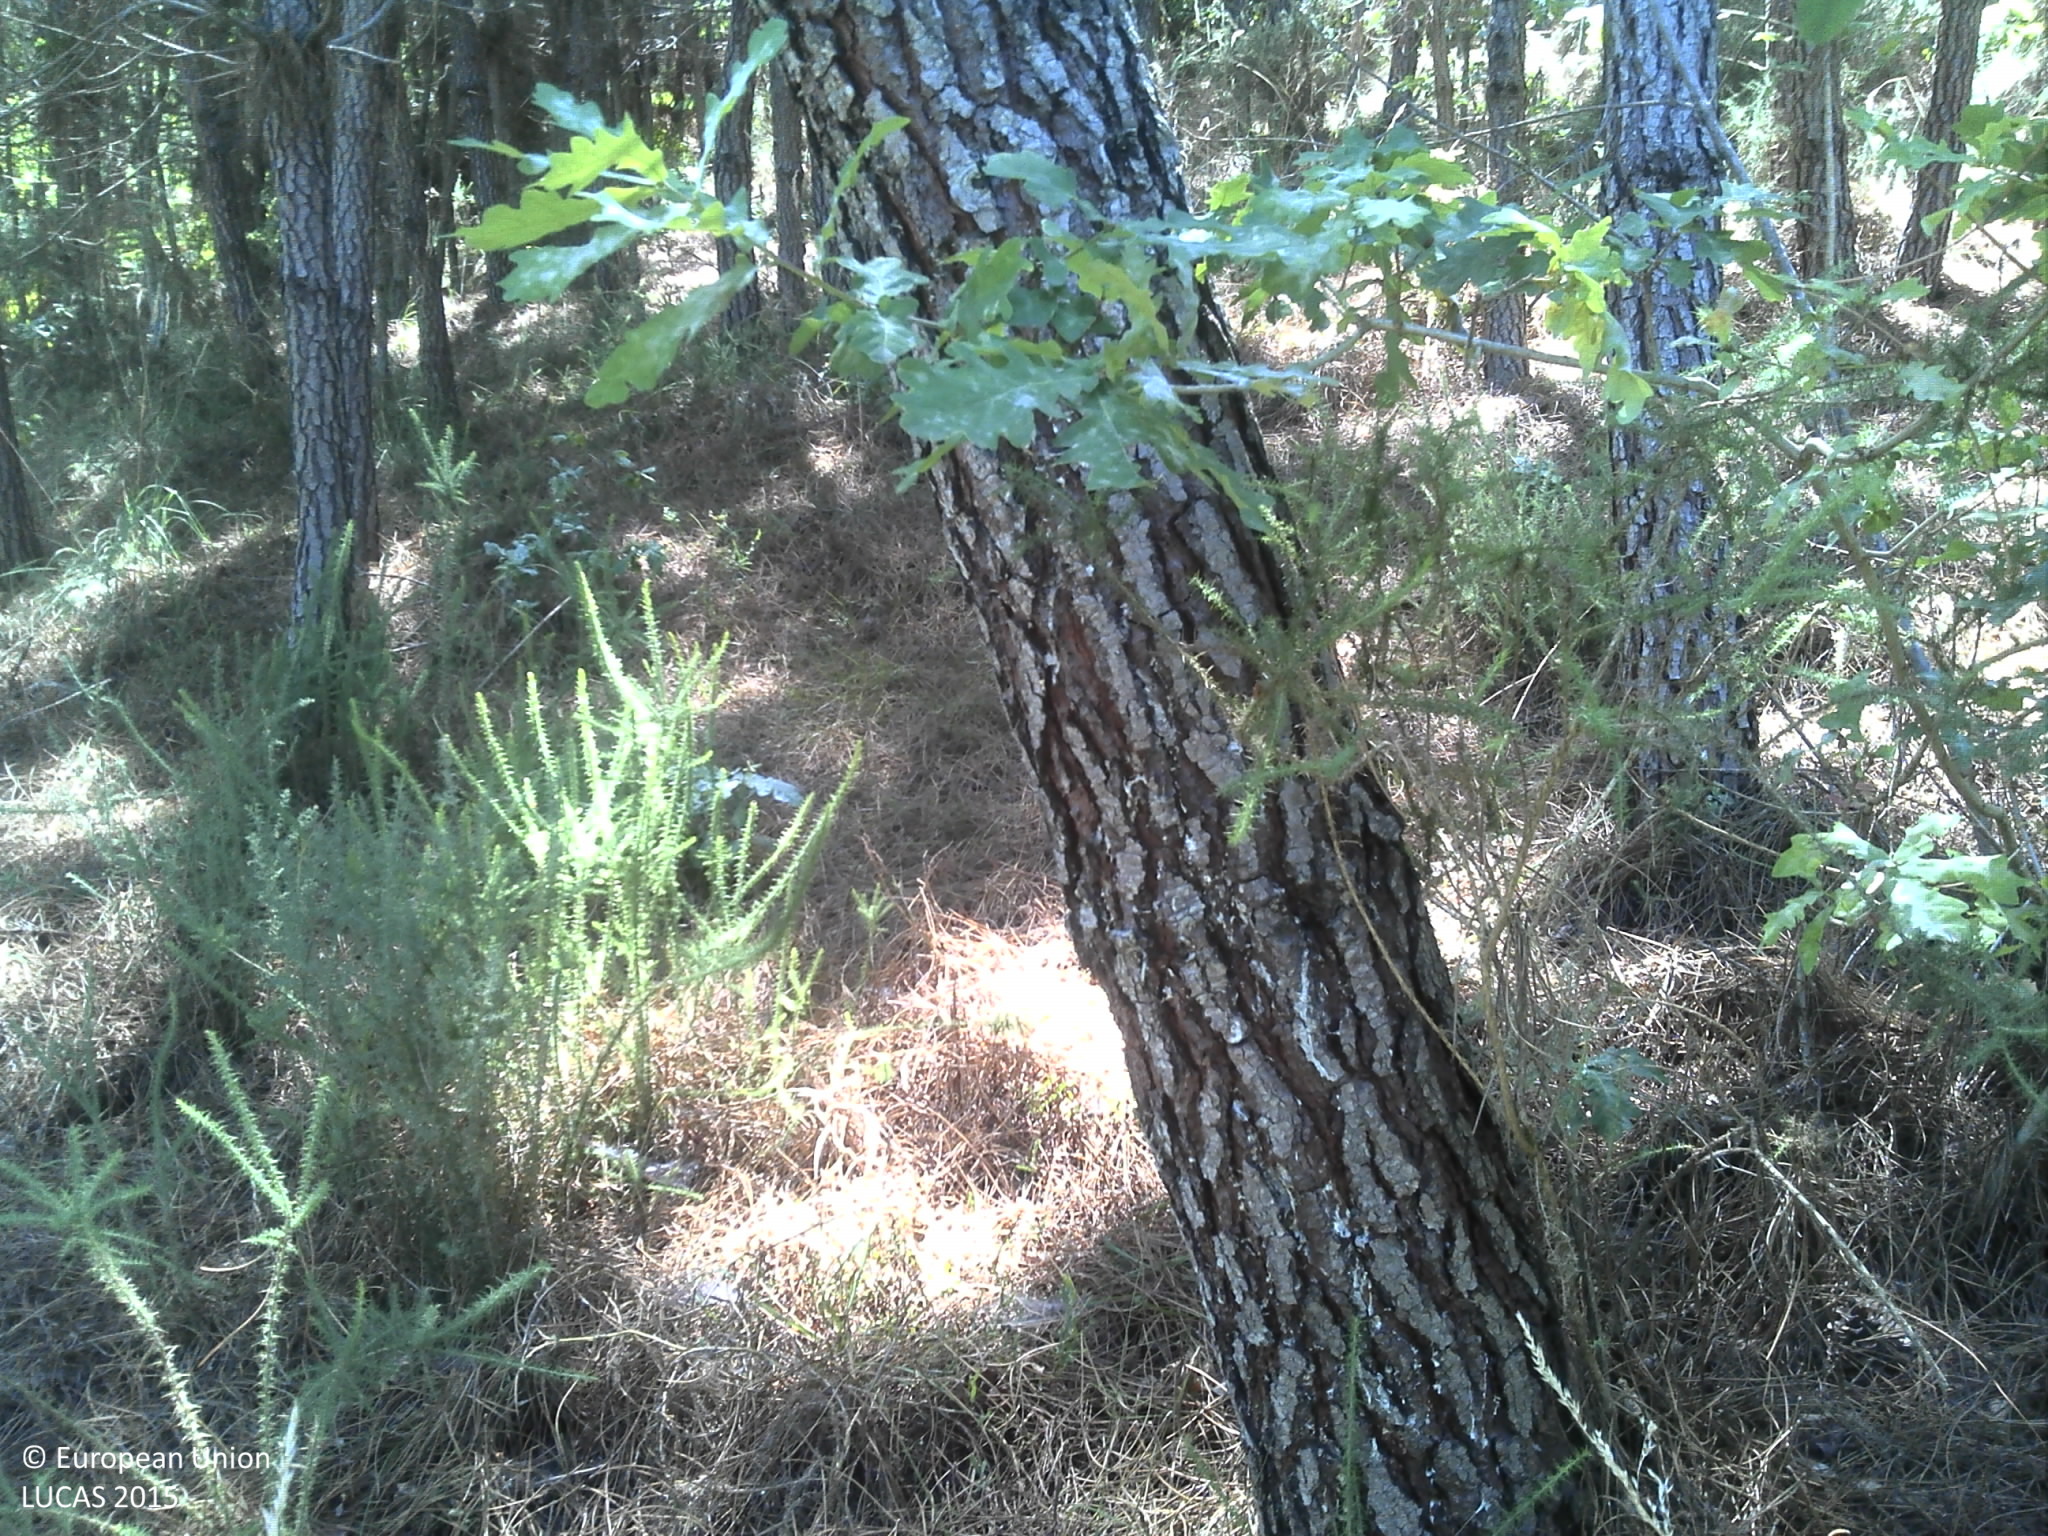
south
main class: Woodland
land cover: Pine dominated coniferous woodland
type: coniferous forest of the mediterranean region
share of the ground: > 75 %
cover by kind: coniferous forest trees 75 %, shrubs 15 %, broadleaved forest trees 5 %, unconsolidated bare surface 5 %
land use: Forestry
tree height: > 5 m
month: June
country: PT
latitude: 41.4089
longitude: -8.0242
